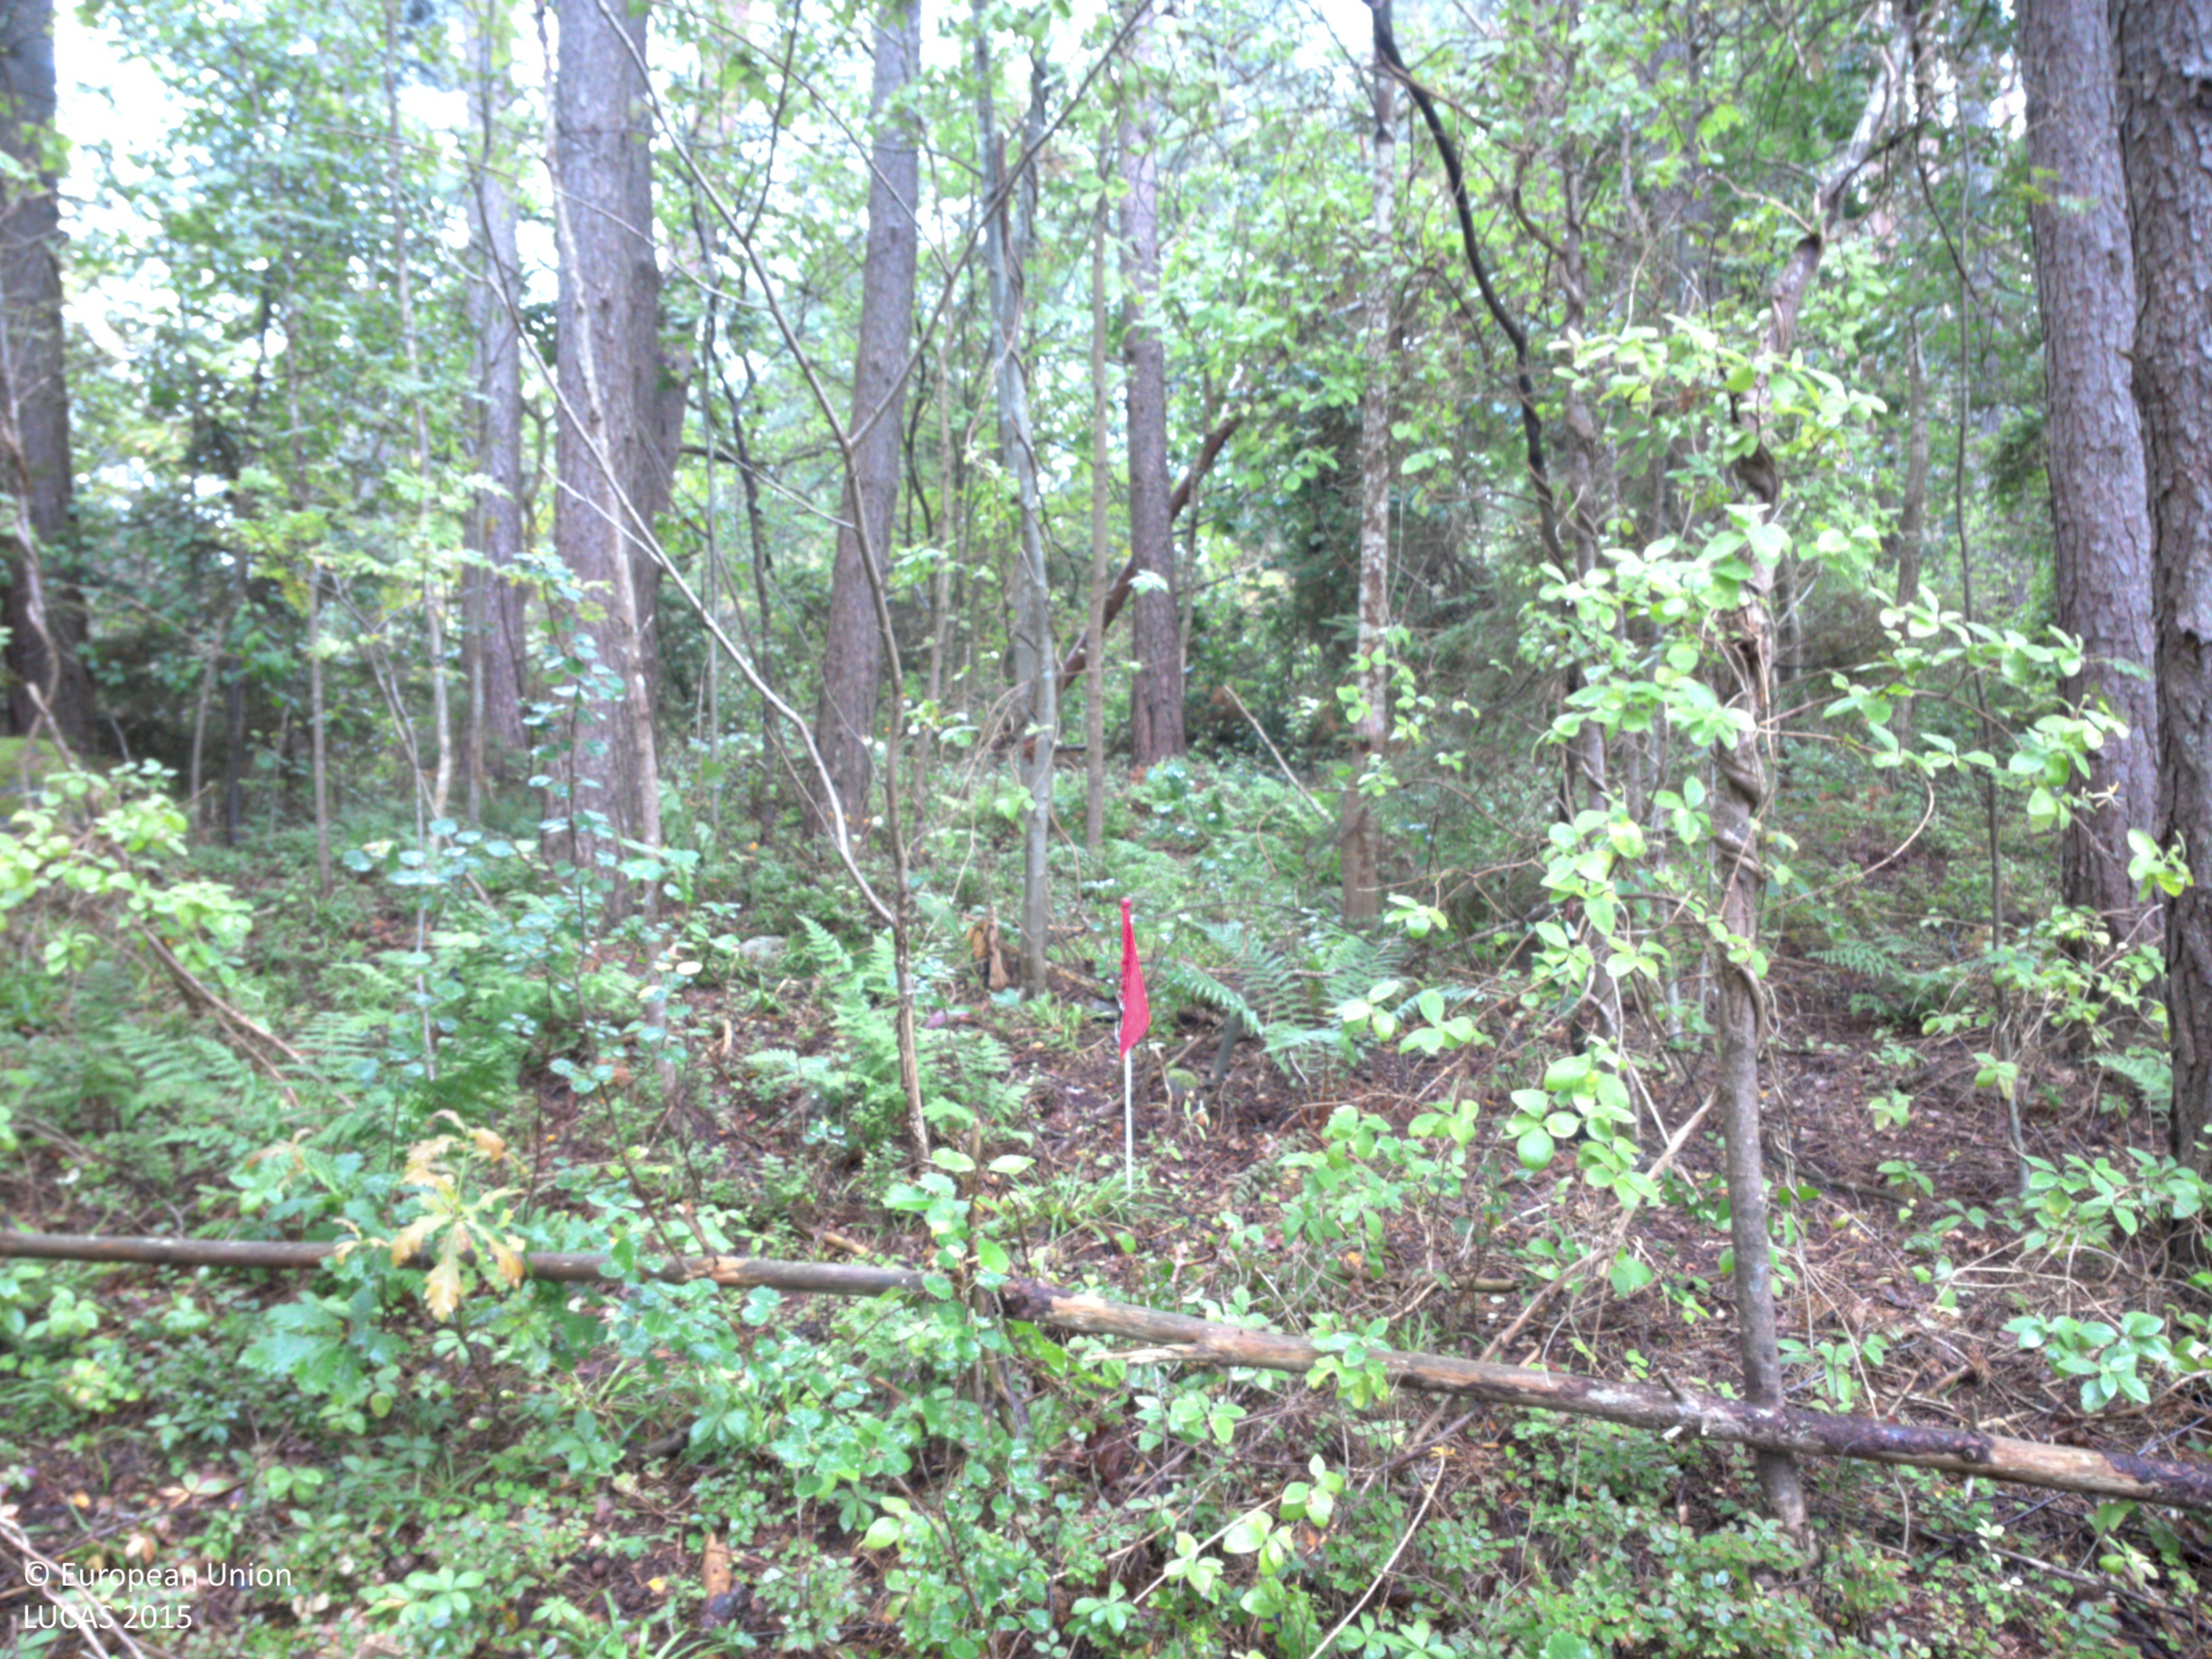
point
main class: Woodland
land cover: Pine dominated mixed woodland
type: boreal forest
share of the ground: 50 - 75 %
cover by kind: coniferous forest trees 35 %, broadleaved forest trees 25 %, herbaceous plants 20 %, consolidated bare surface 20 %
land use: Semi-natural and natural areas not in use
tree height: > 5 m
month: July
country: SE
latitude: 58.0643
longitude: 11.7425
